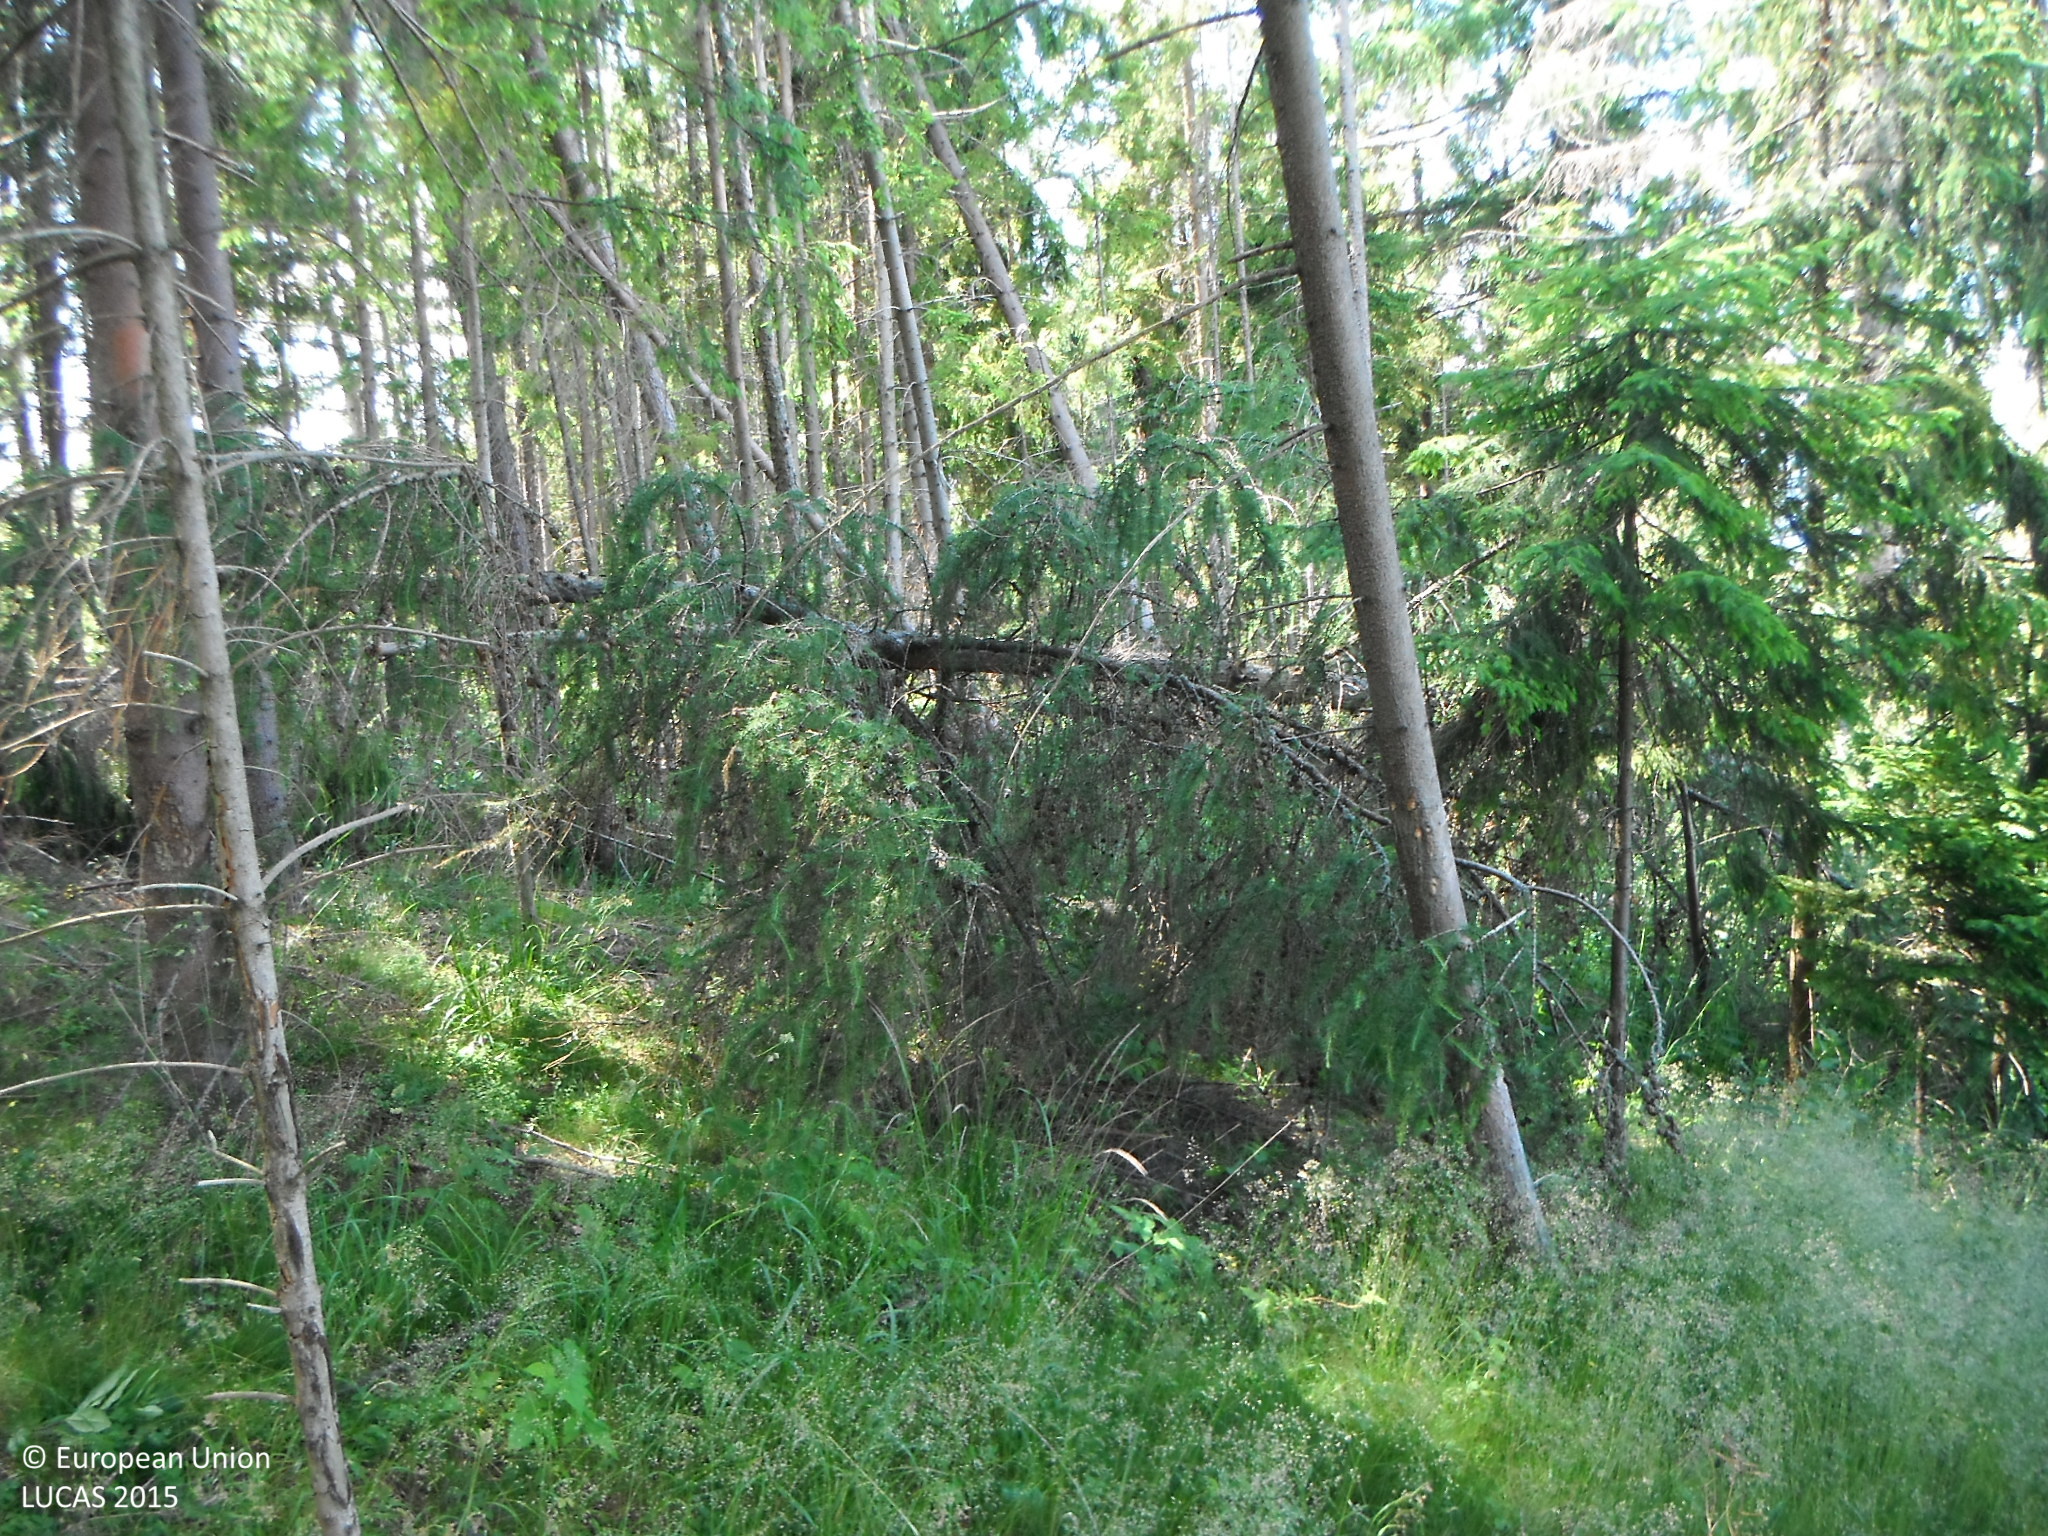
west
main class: Woodland
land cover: Spruce dominated coniferous woodland
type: alpine coniferous forest
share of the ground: > 75 %
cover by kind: coniferous forest trees 85 %, herbaceous plants 15 %
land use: Forestry
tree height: > 5 m
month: July
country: SK
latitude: 48.9762
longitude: 20.2665
